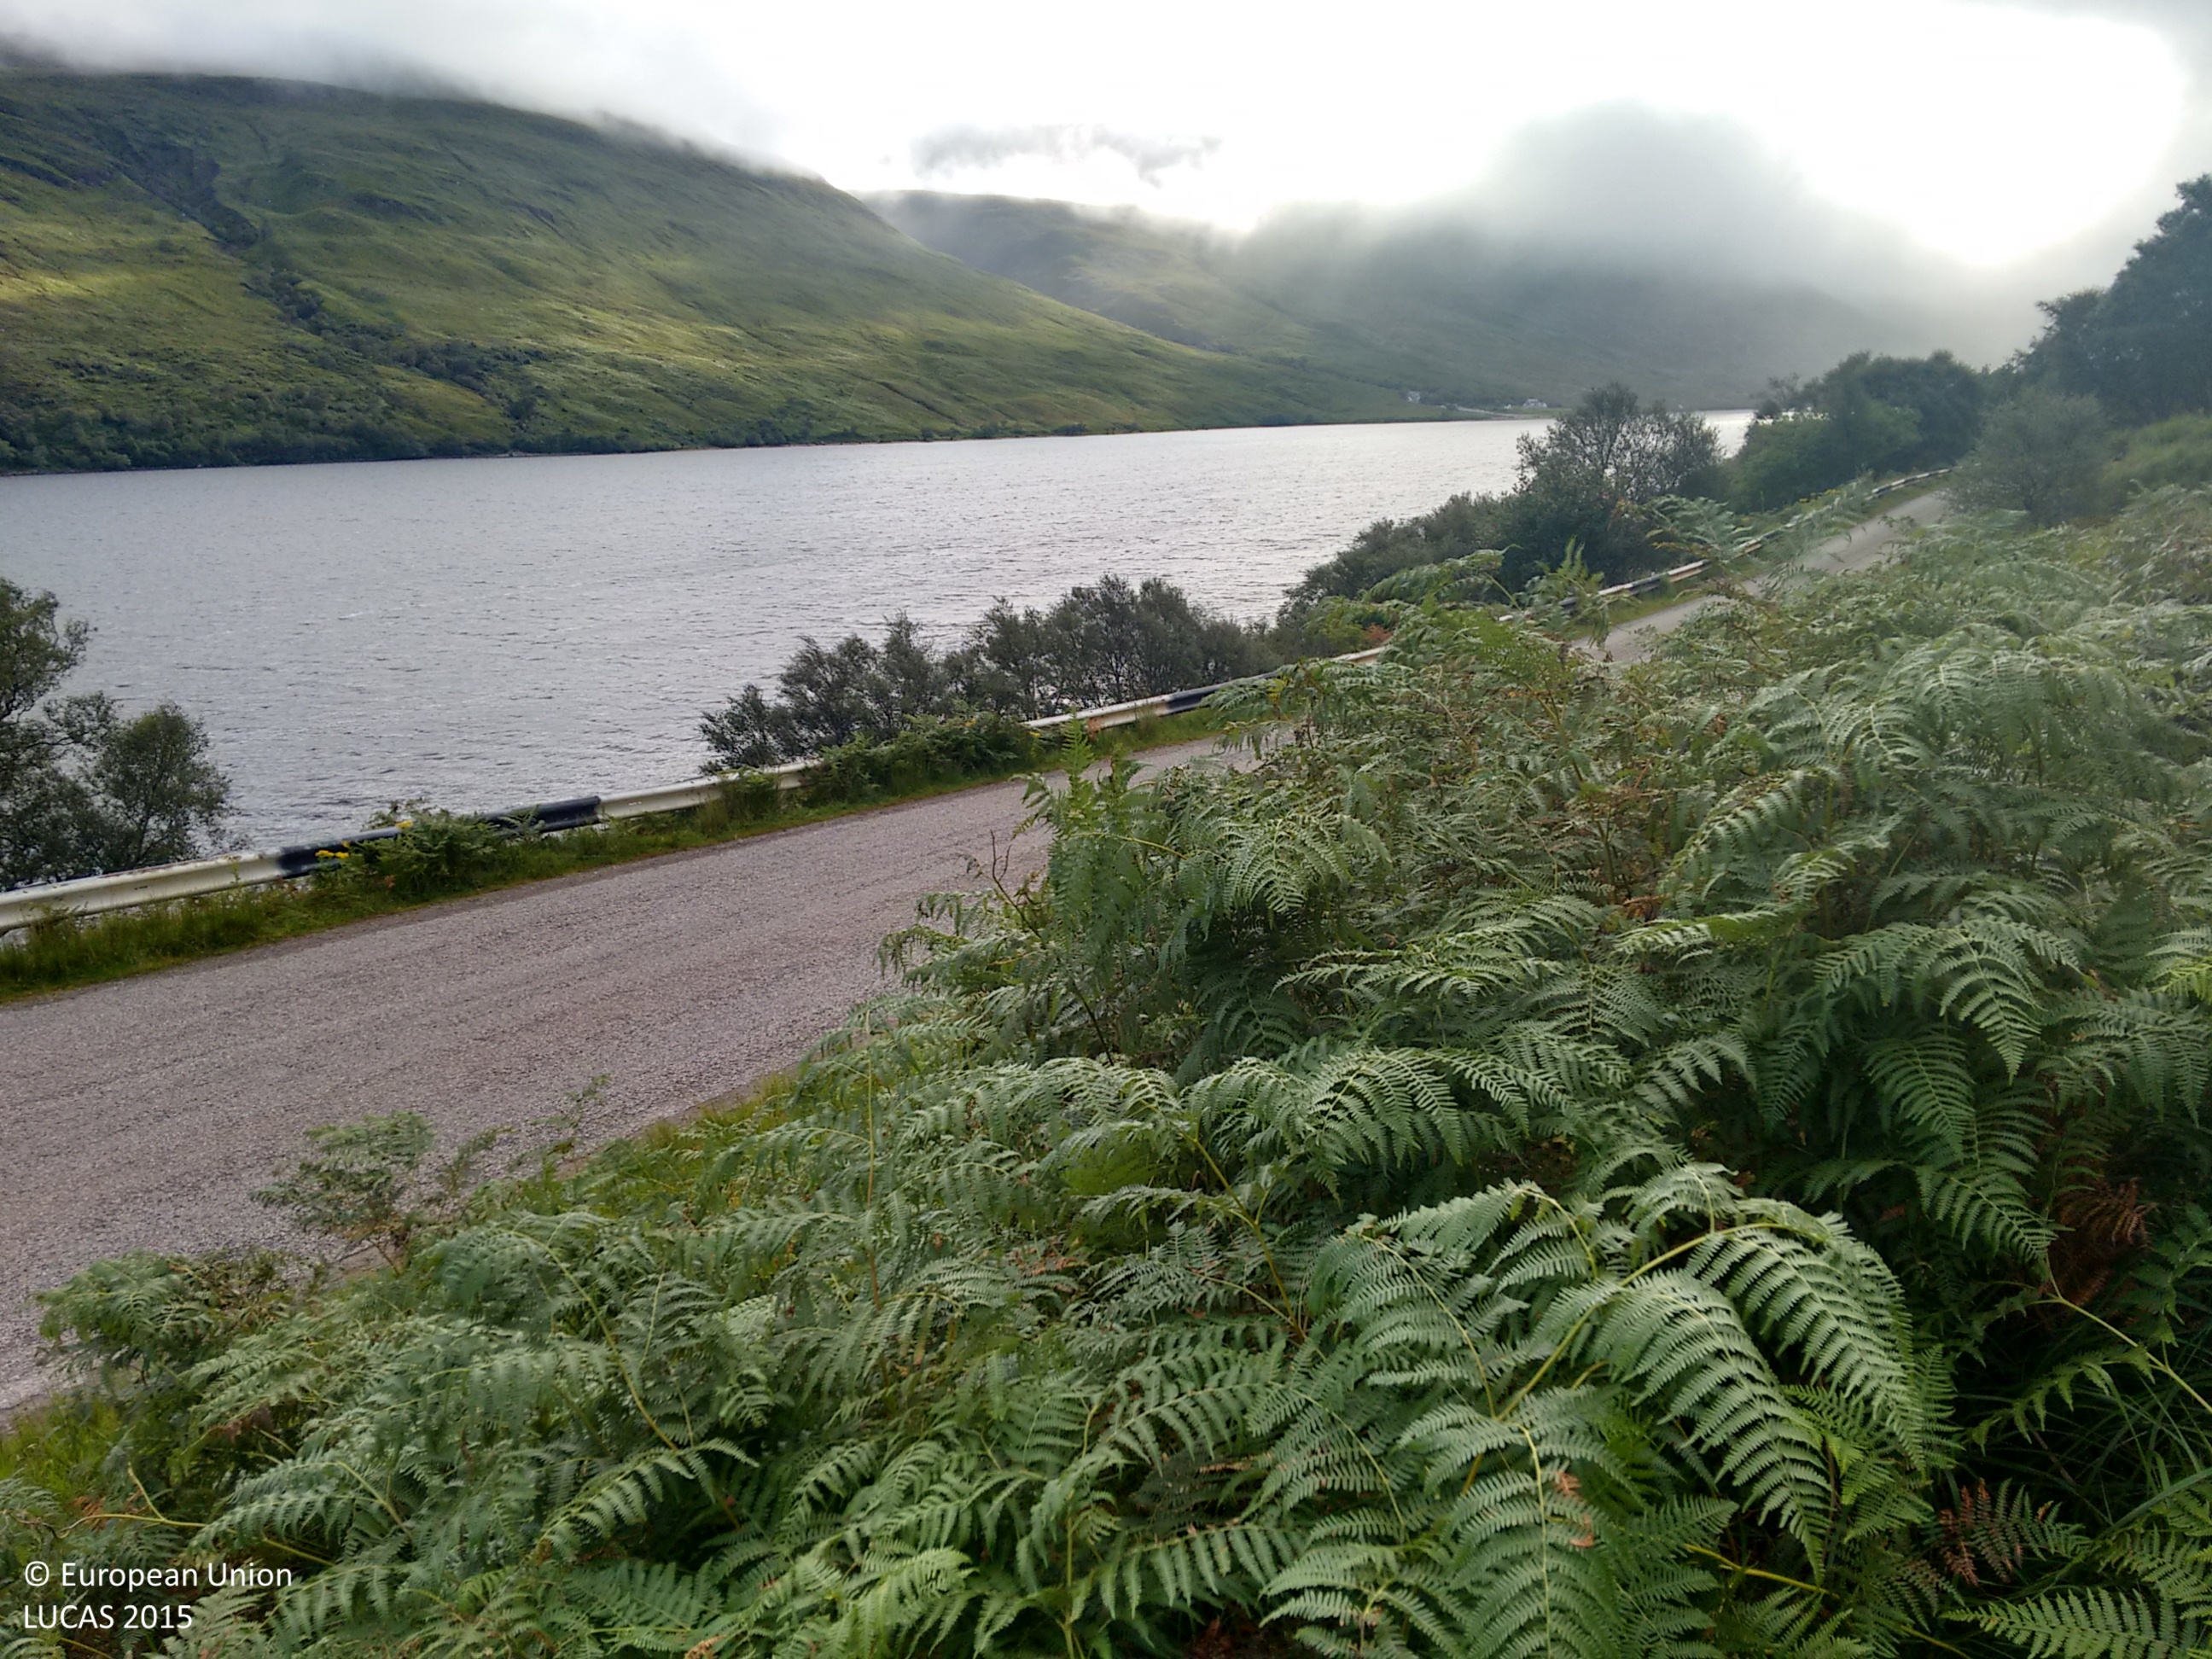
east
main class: Grassland
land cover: Grassland with sparse tree/shrub cover
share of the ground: > 75 %
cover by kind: herbaceous plants 85 %, shrubs 10 %, broadleaved forest trees 5 %
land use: Semi-natural and natural areas not in use
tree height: > 5 m
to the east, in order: Grassland with sparse tree/shrub cover; Ditches and canals; Grass margins; Paved roads, cycling and walking lanes; Grass margins; Grassland with sparse tree/shrub cover; Sand; Inland fresh water bodies
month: September
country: GB
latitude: 58.2869
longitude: -4.8477
